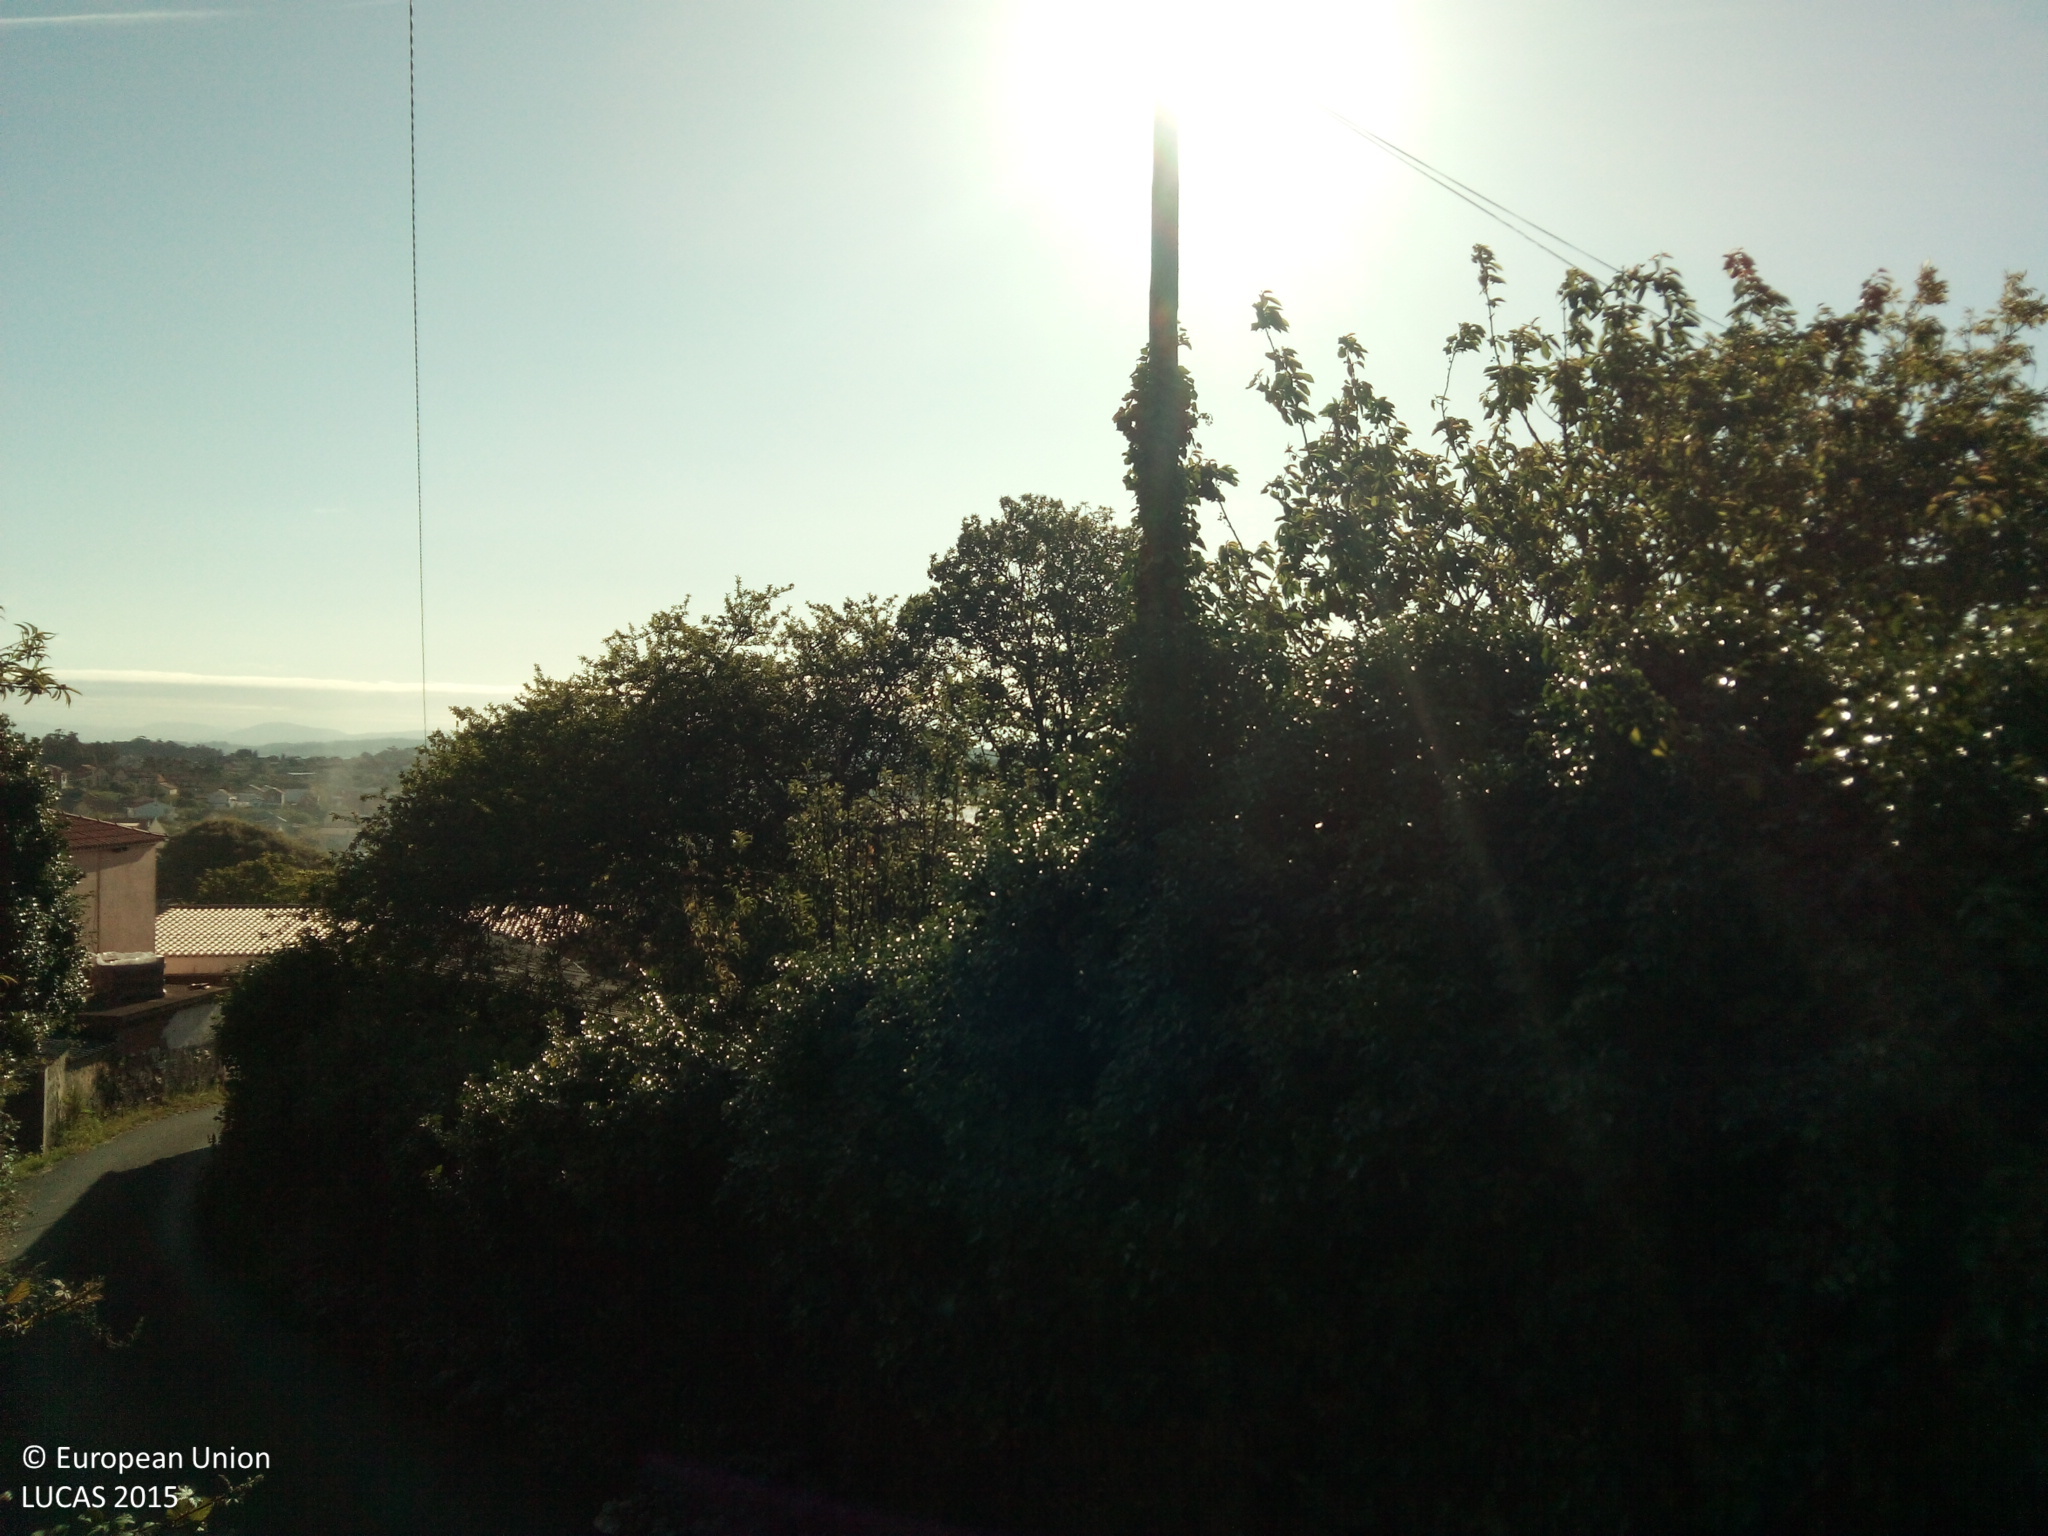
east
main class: Cropland
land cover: Cherry fruit
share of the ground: 25 - 50 %
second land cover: Spontaneously vegetated surfaces
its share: > 75 %
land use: Agriculture (excluding fallow land and kitchen gardens)
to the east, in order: Cherry fruit; Spontaneously vegetated surfaces; Artificial constructions in urban areas; Dry stone walls; Other fruit trees and berries; Electric lines; Other fruit trees and berries; Dry stone walls; Artificial constructions in urban areas
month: May
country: ES
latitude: 42.5819
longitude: -8.9634
